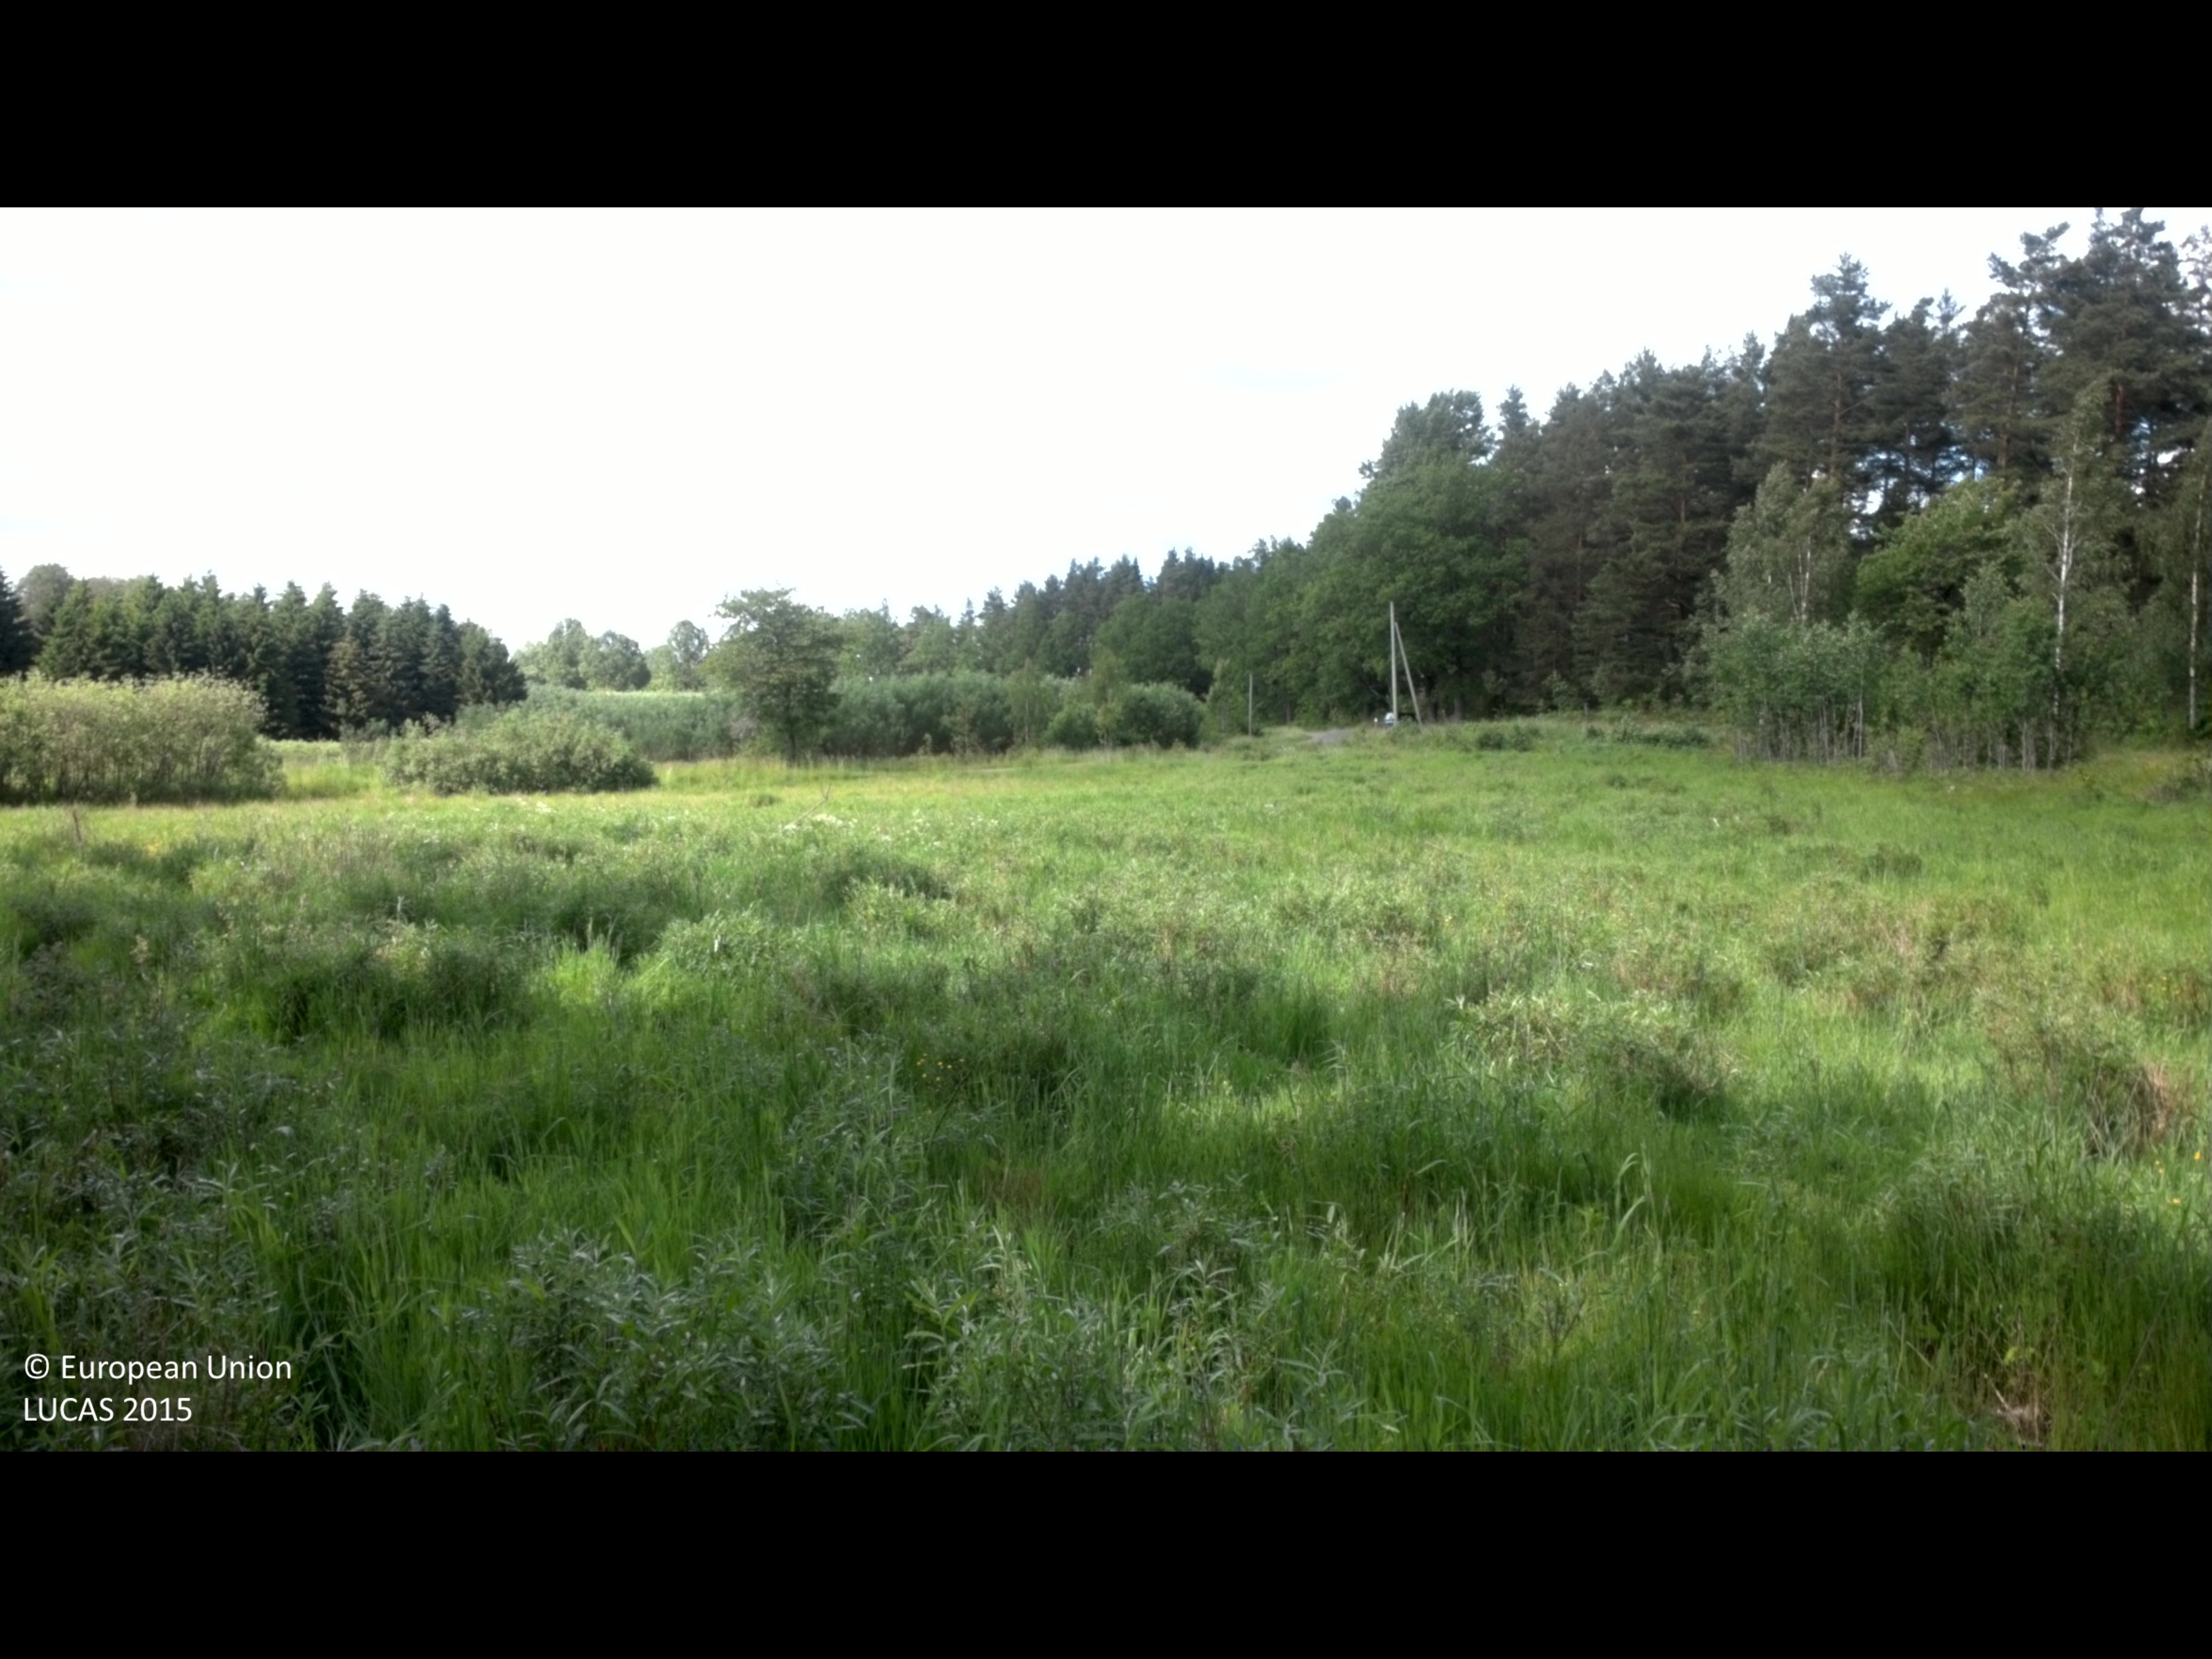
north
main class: Cropland
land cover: Permanent industrial crops
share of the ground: 25 - 50 %
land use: Agriculture (excluding fallow land and kitchen gardens)
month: June
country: SE
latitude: 57.7520
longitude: 16.5687
